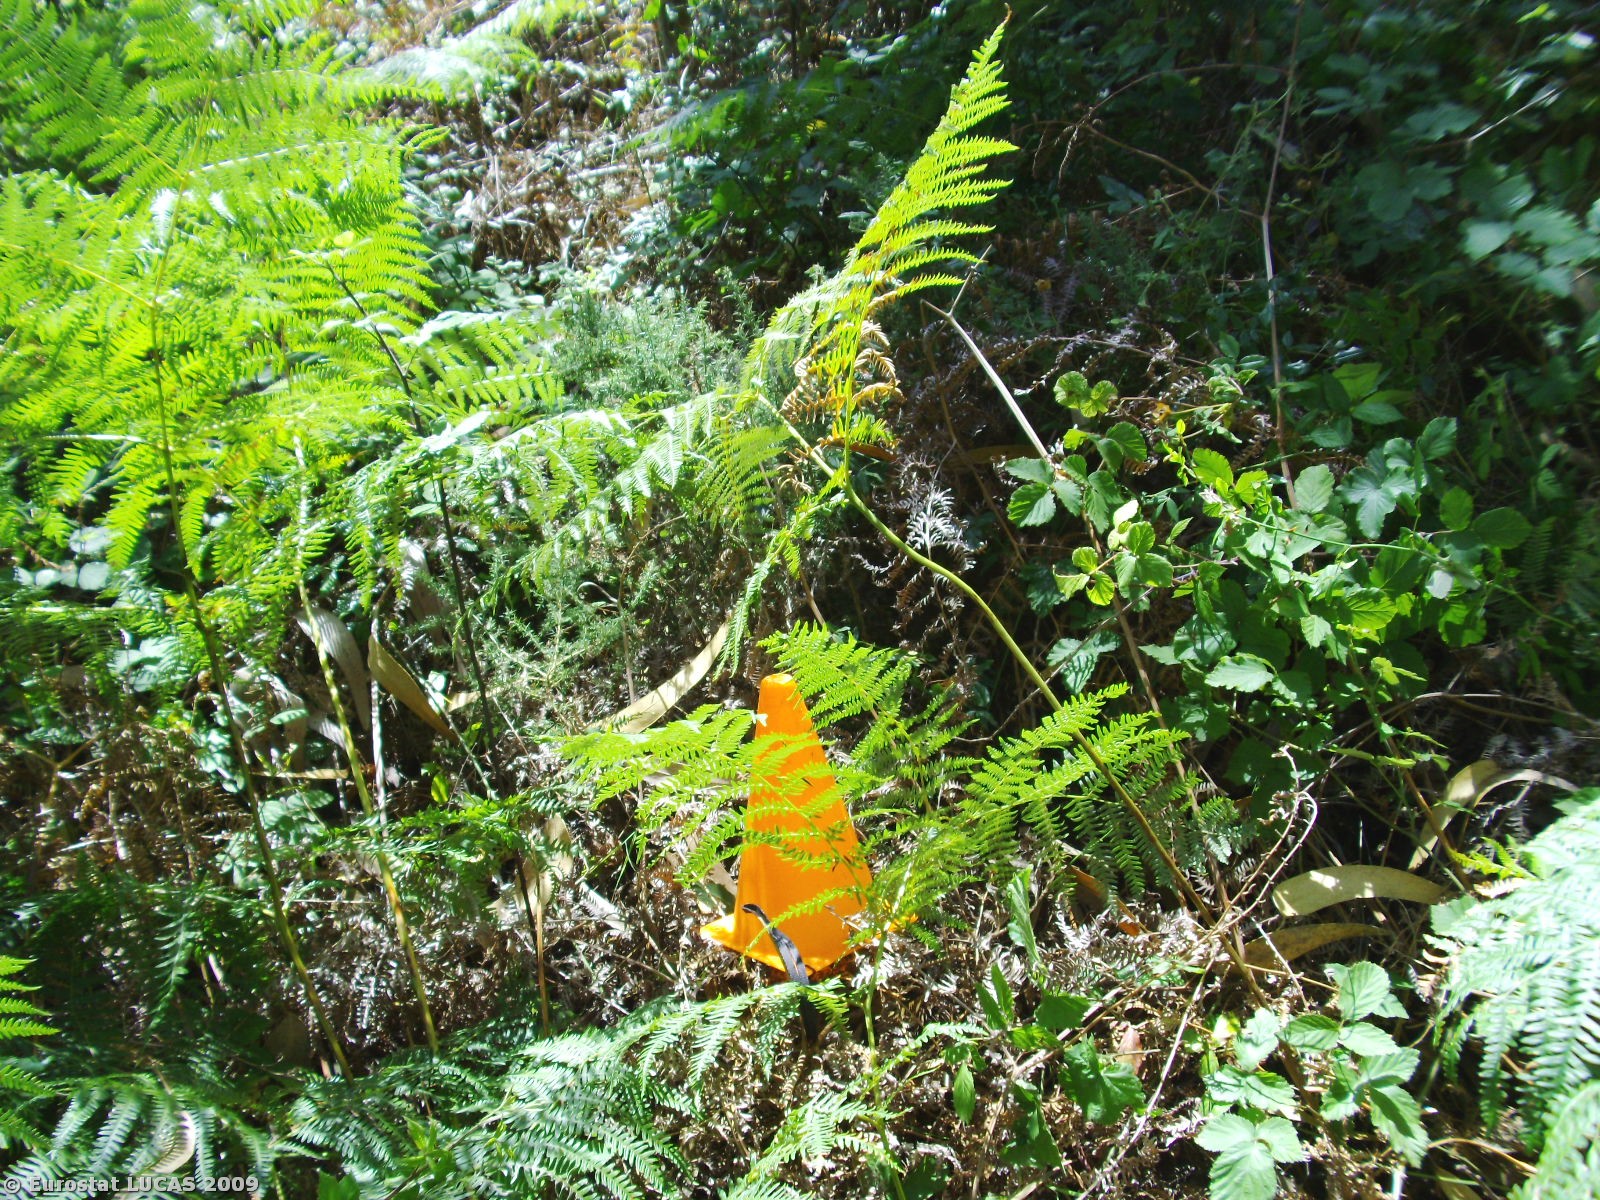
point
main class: Shrubland
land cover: Shrubland with sparse tree cover
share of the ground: > 75 %
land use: Unused
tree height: > 5 m
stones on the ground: 10 - 25 %
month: July
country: PT
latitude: 38.9524
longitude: -9.2494
